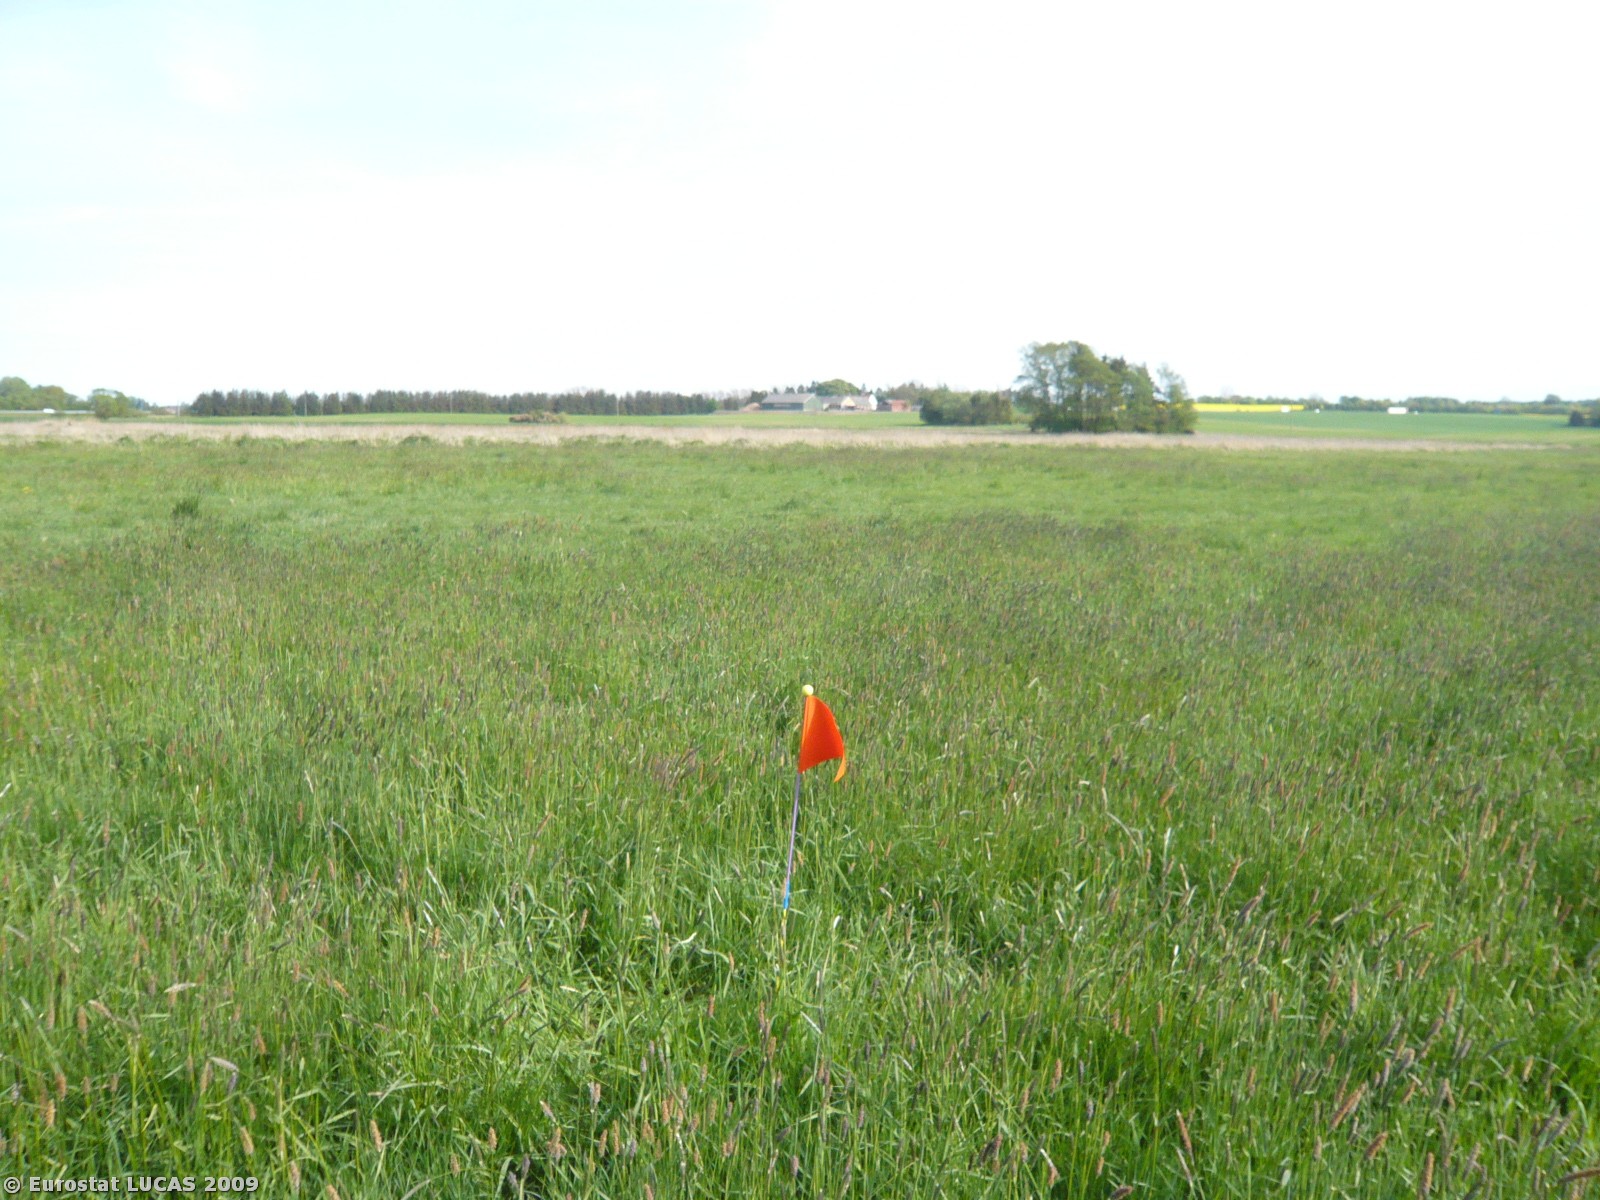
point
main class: Grassland
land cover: Grassland without tree/shrub cover
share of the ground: > 75 %
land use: Agriculture (excluding fallow land and kitchen gardens)
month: May
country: DK
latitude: 55.2732
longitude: 11.9975
